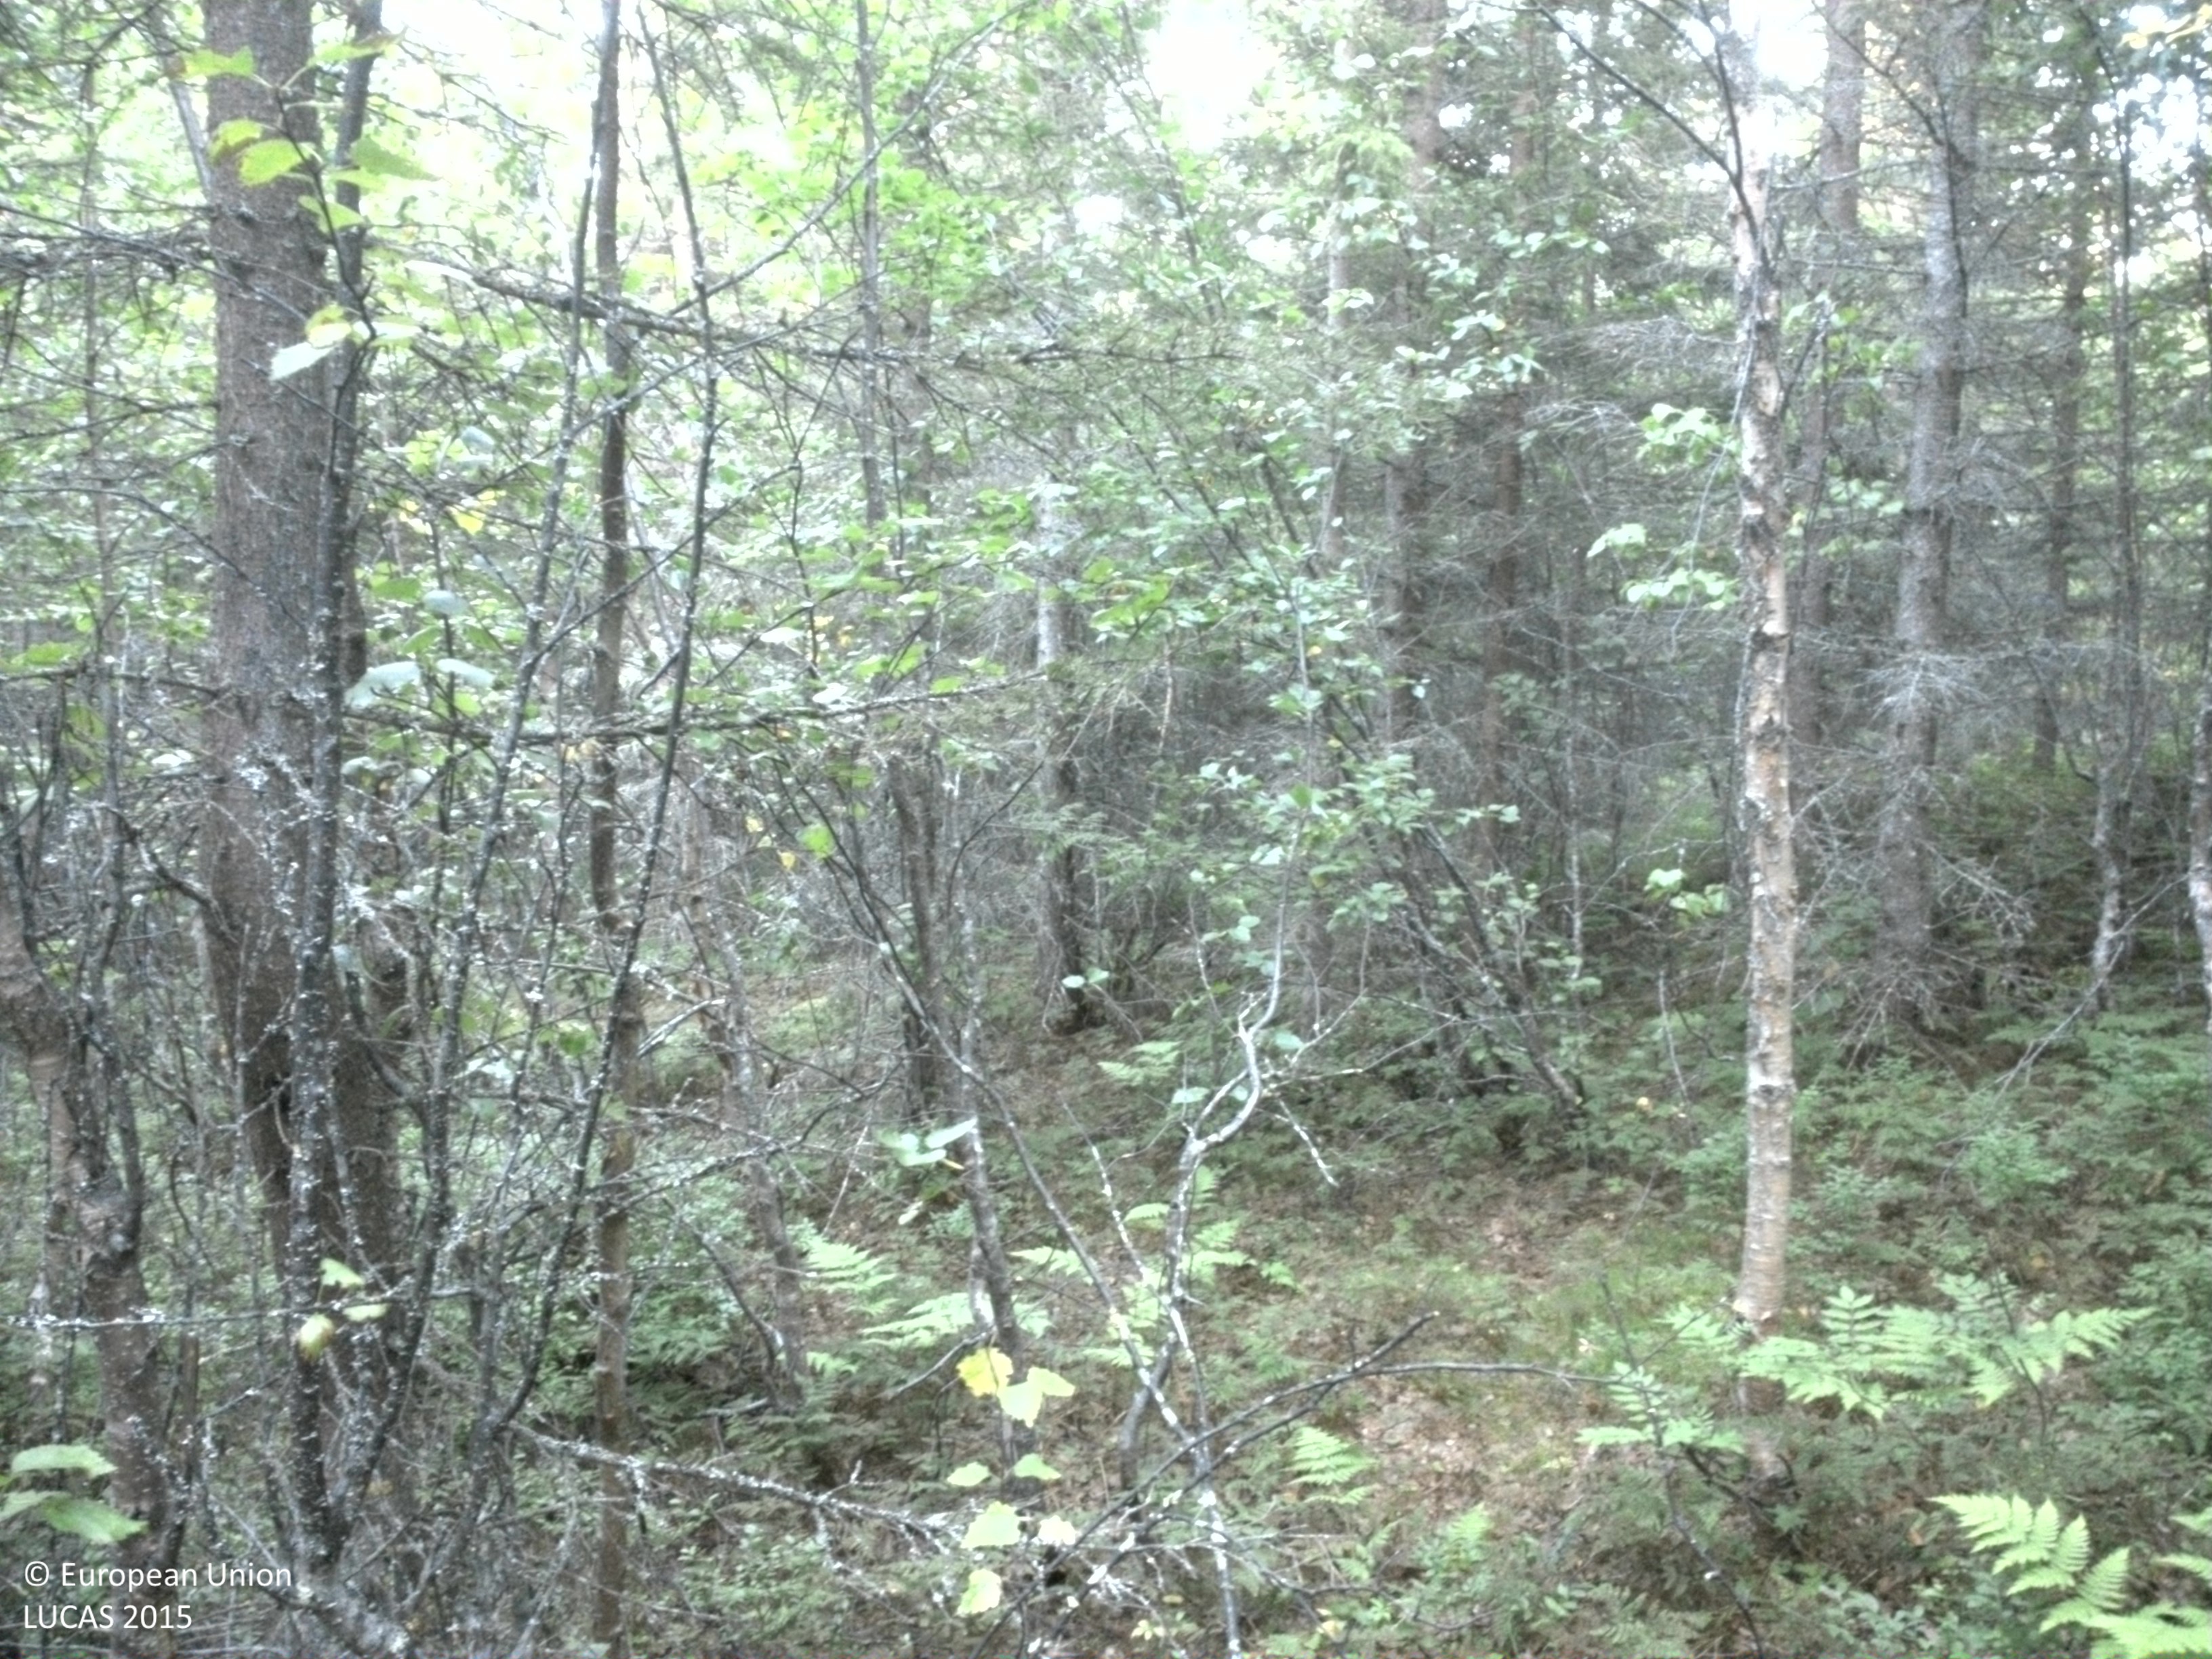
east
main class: Woodland
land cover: Spruce dominated mixed woodland
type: boreal forest
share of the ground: > 75 %
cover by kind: coniferous forest trees 60 %, broadleaved forest trees 20 %, shrubs 10 %, herbaceous plants 10 %
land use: Forestry
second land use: Amenities, museums, leisure
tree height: > 5 m
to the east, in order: Spruce dominated mixed woodland; Ditches and canals; Spruce dominated mixed woodland; Spruce dominated coniferous woodland
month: August
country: SE
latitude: 64.3774
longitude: 18.3629
